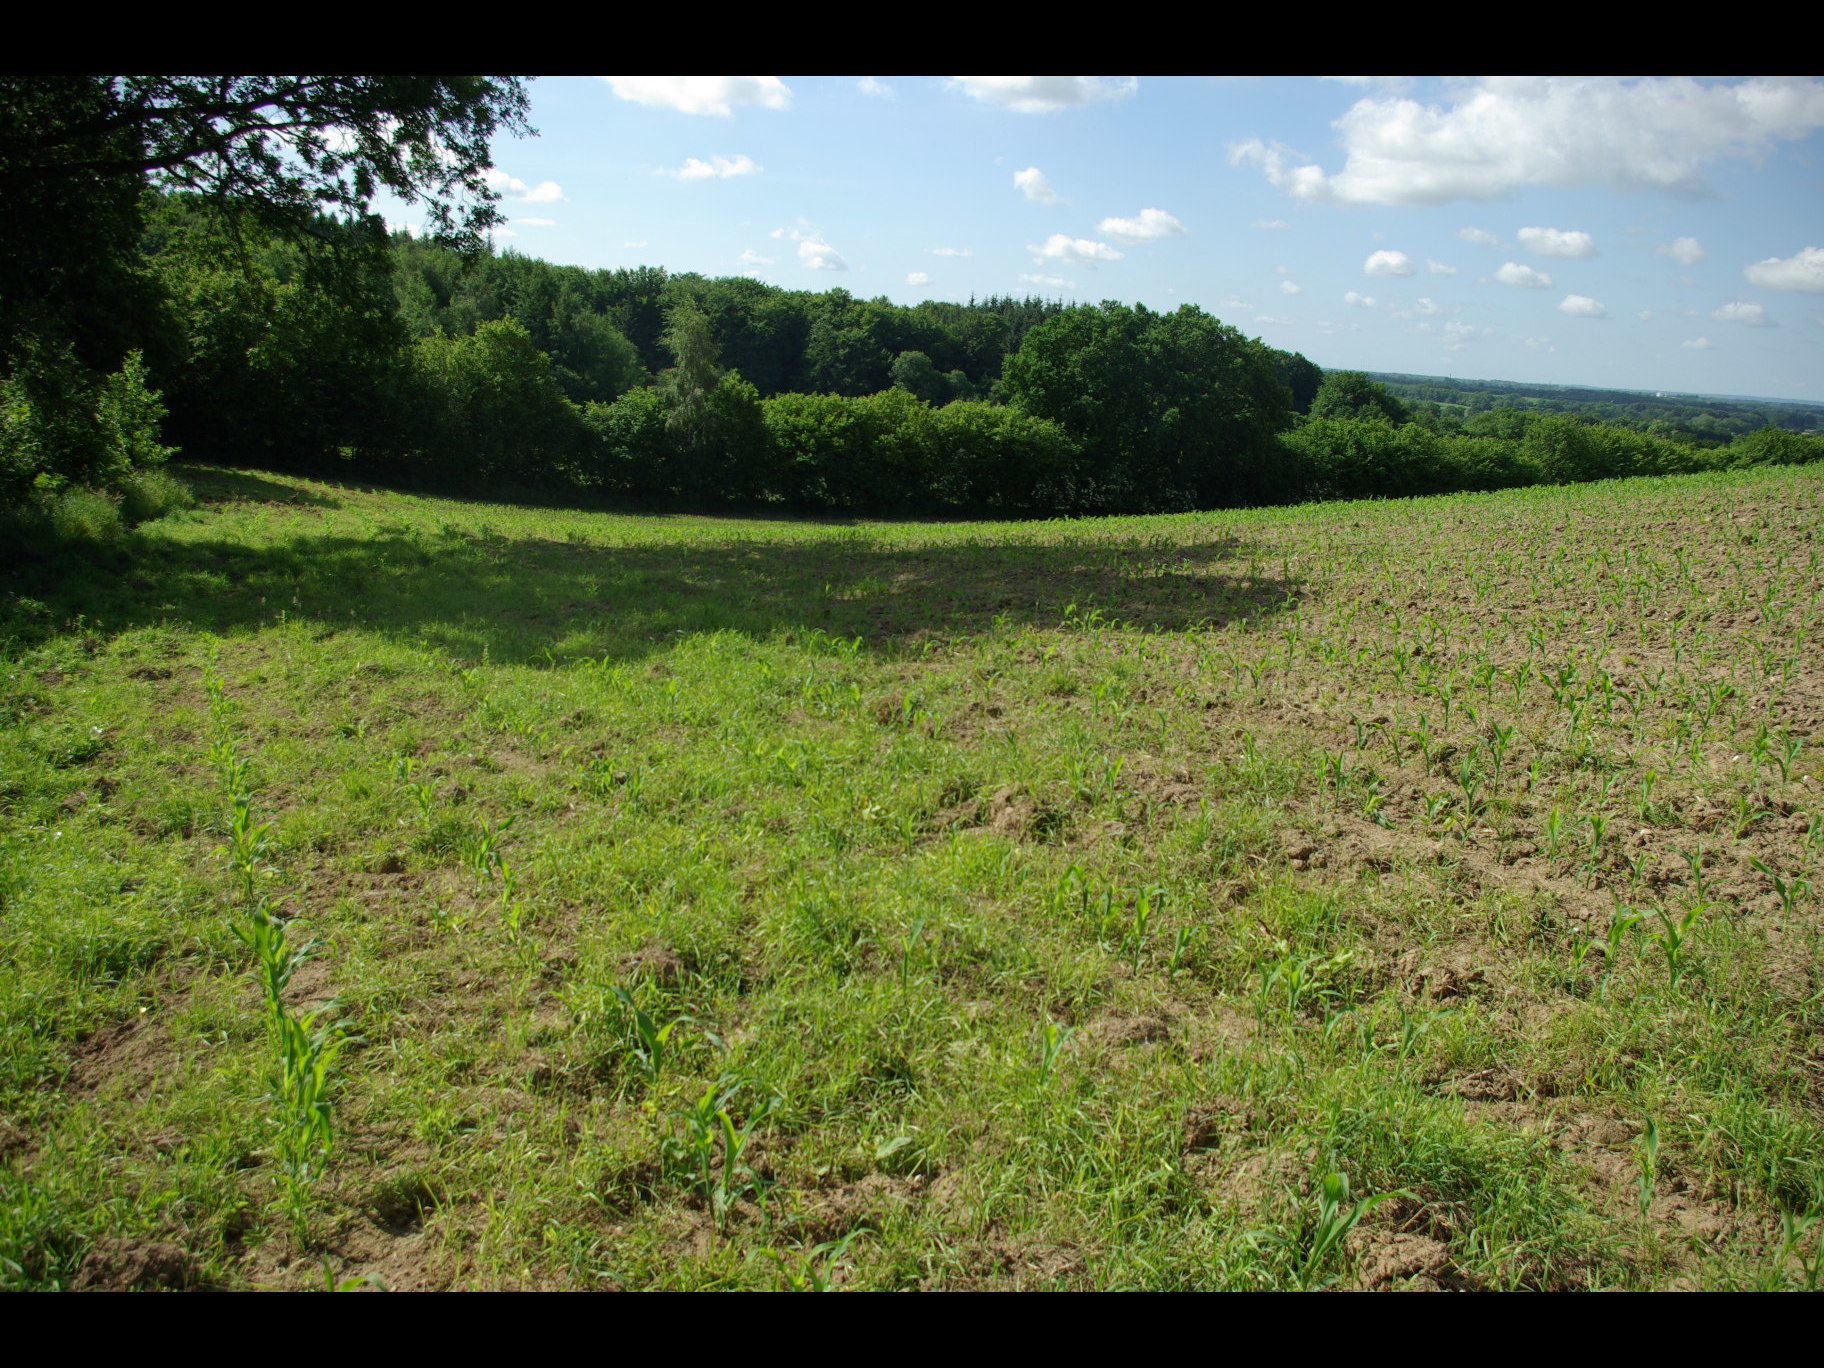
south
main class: Cropland
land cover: Maize
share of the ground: 10 - 25 %
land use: Agriculture (excluding fallow land and kitchen gardens)
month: June
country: DE
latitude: 54.2466
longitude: 9.8926
